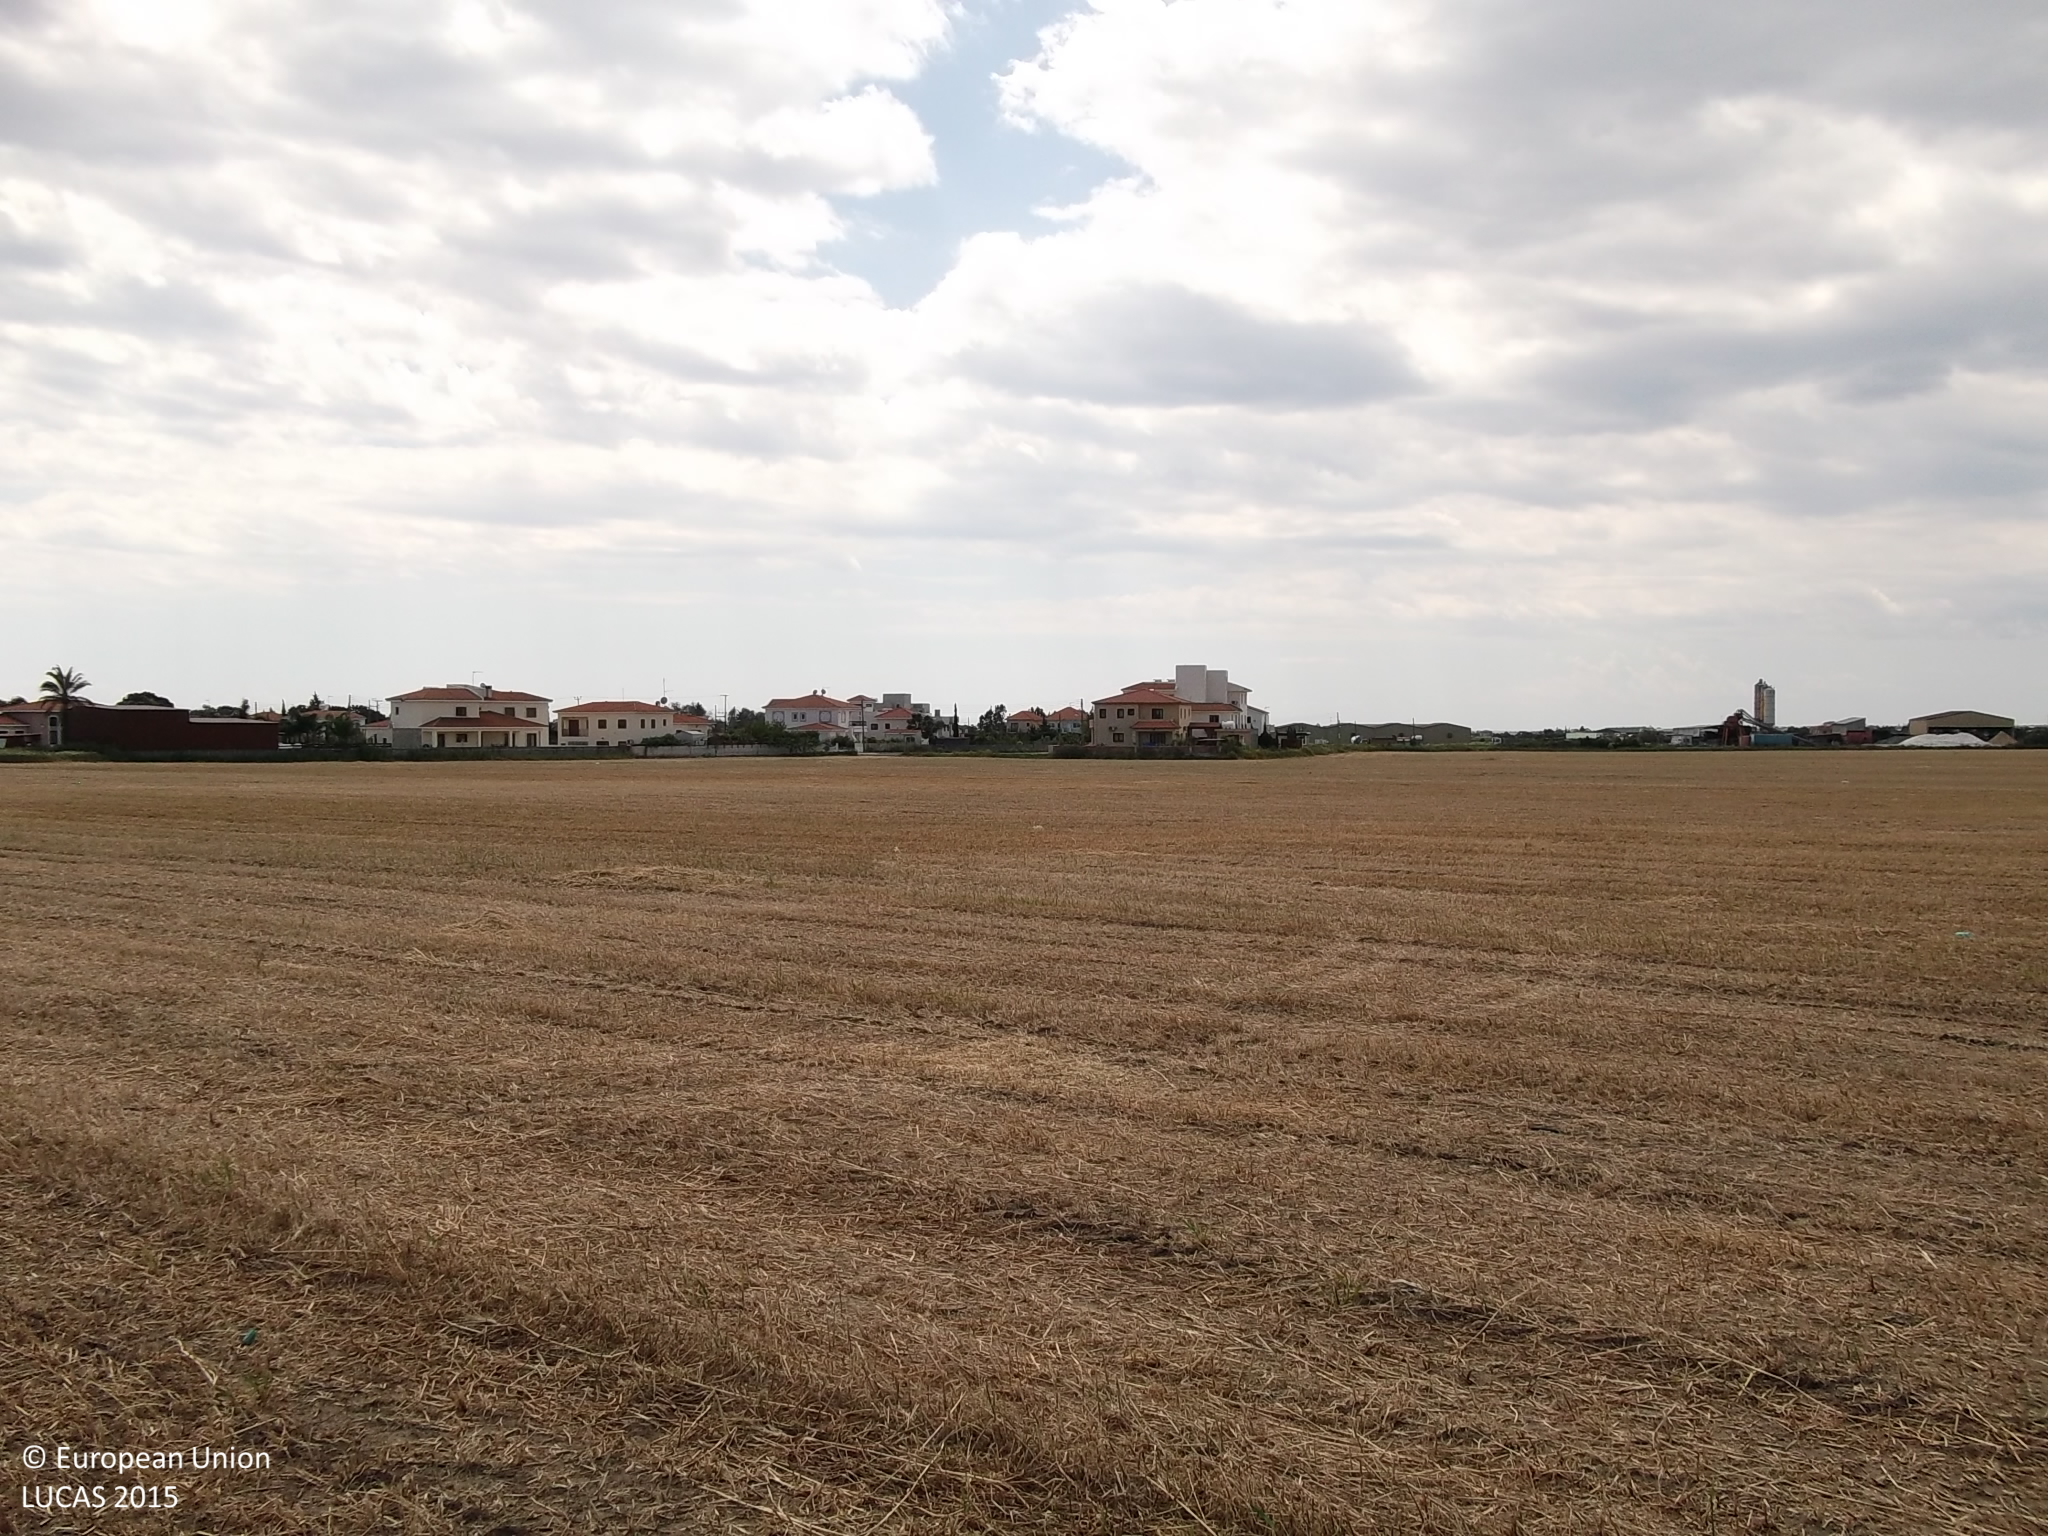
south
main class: Cropland
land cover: Common wheat
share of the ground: < 10 %
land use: Agriculture (excluding fallow land and kitchen gardens)
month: April
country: CY
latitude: 34.8541
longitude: 33.5648
